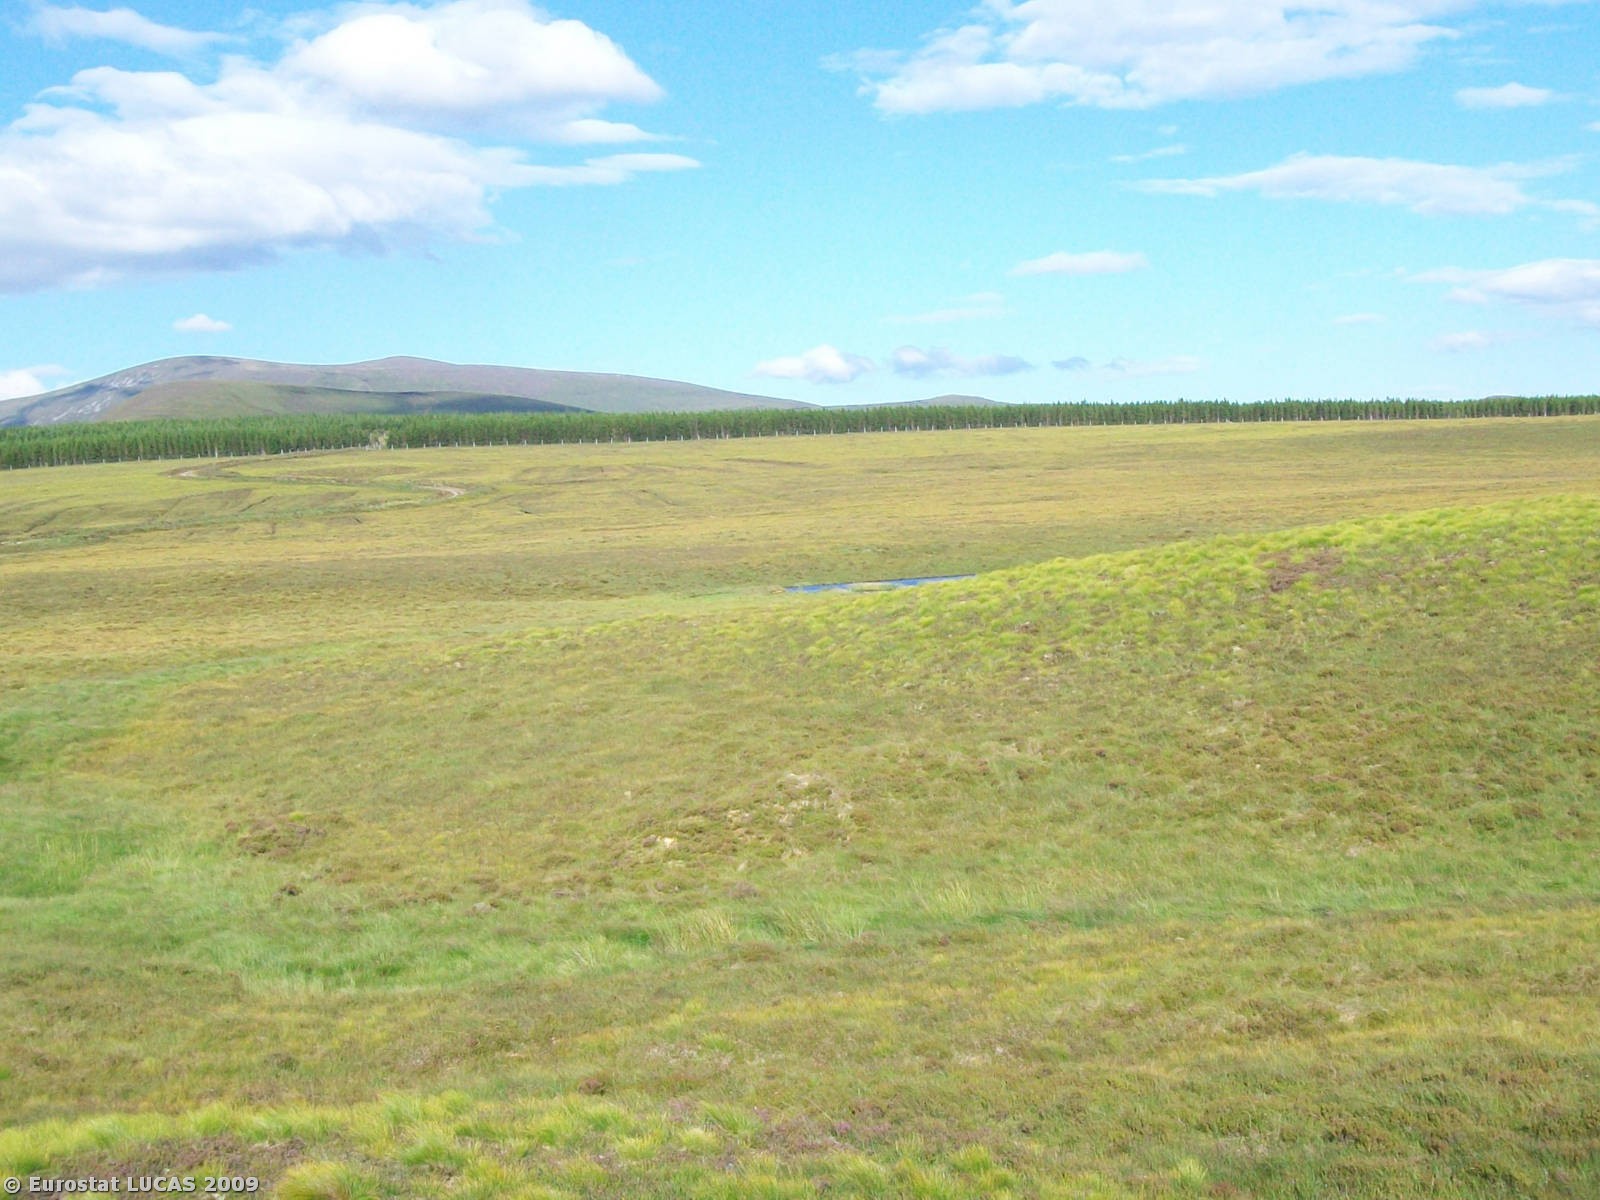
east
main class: Shrubland
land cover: Shrubland without tree cover
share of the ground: > 75 %
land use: Fallow land
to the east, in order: Shrubland without tree cover; Inland water bodies; Shrubland without tree cover
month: August
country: GB
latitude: 58.1935
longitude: -4.5301
